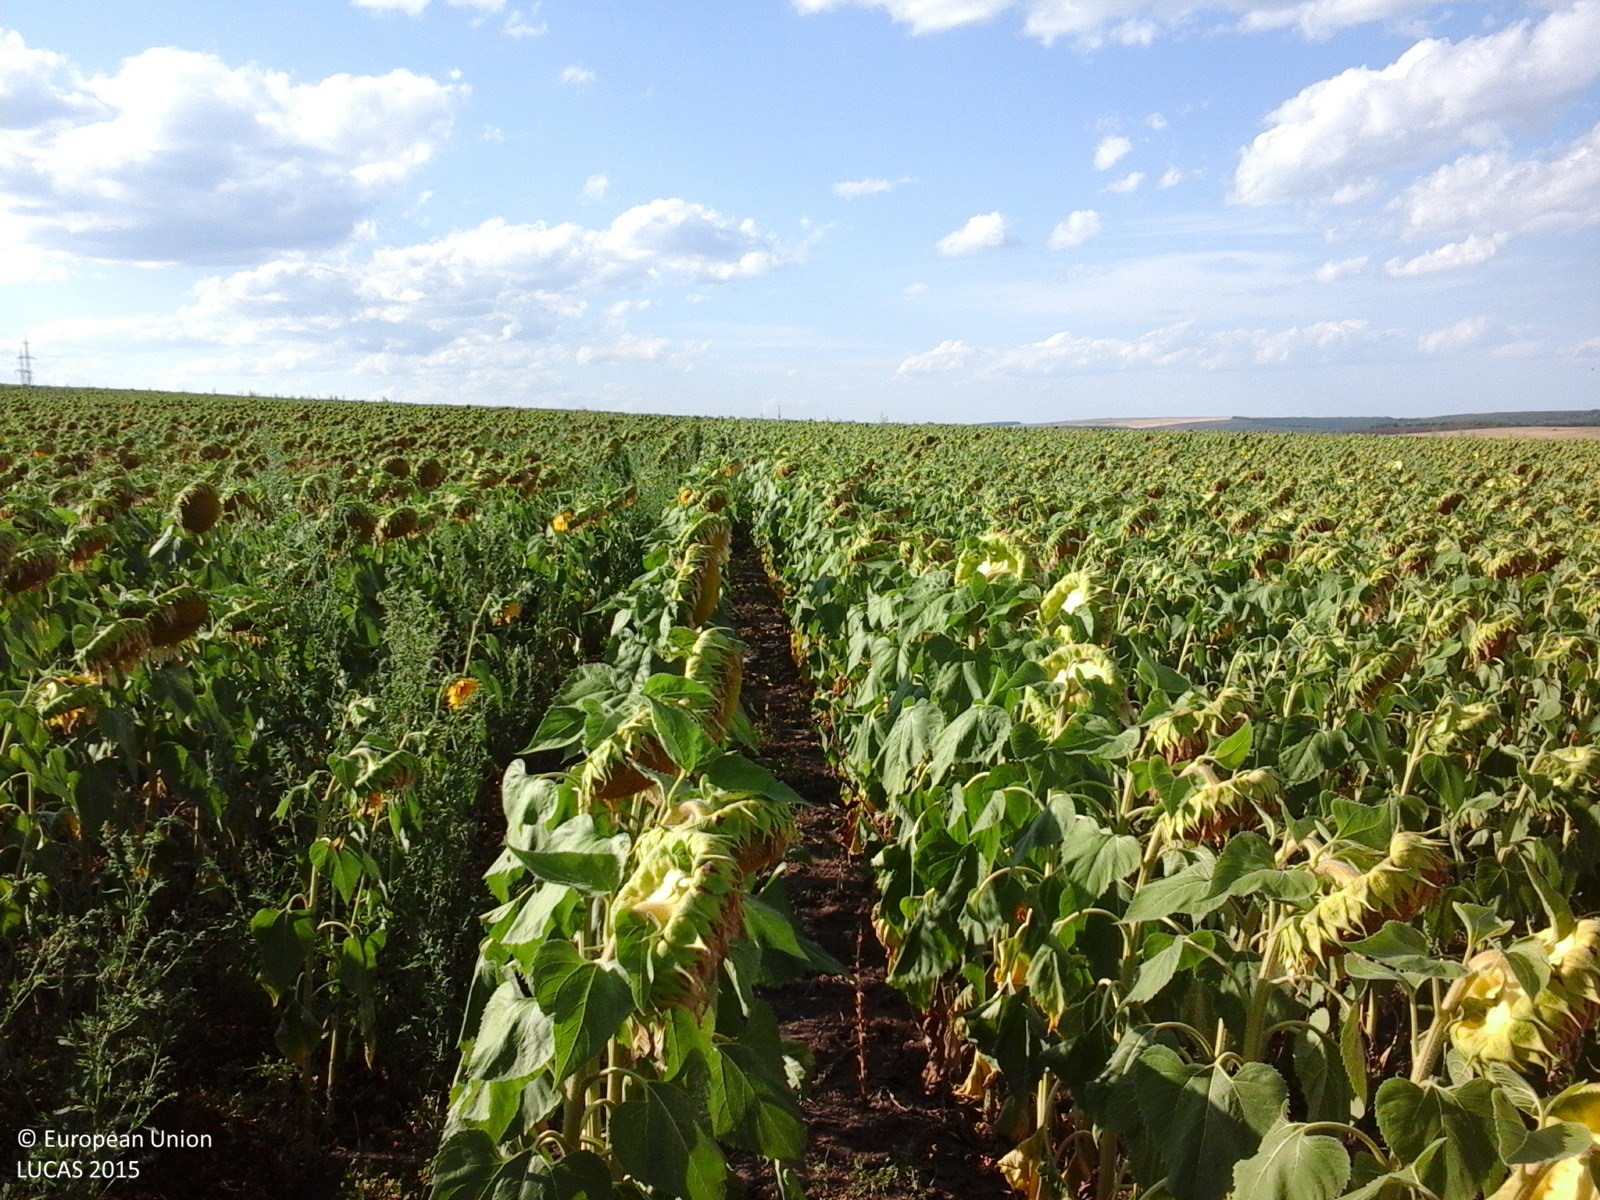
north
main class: Cropland
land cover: Sunflower
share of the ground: > 75 %
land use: Agriculture (excluding fallow land and kitchen gardens)
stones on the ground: < 10 %
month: July
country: RO
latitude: 46.2341
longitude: 27.5243
